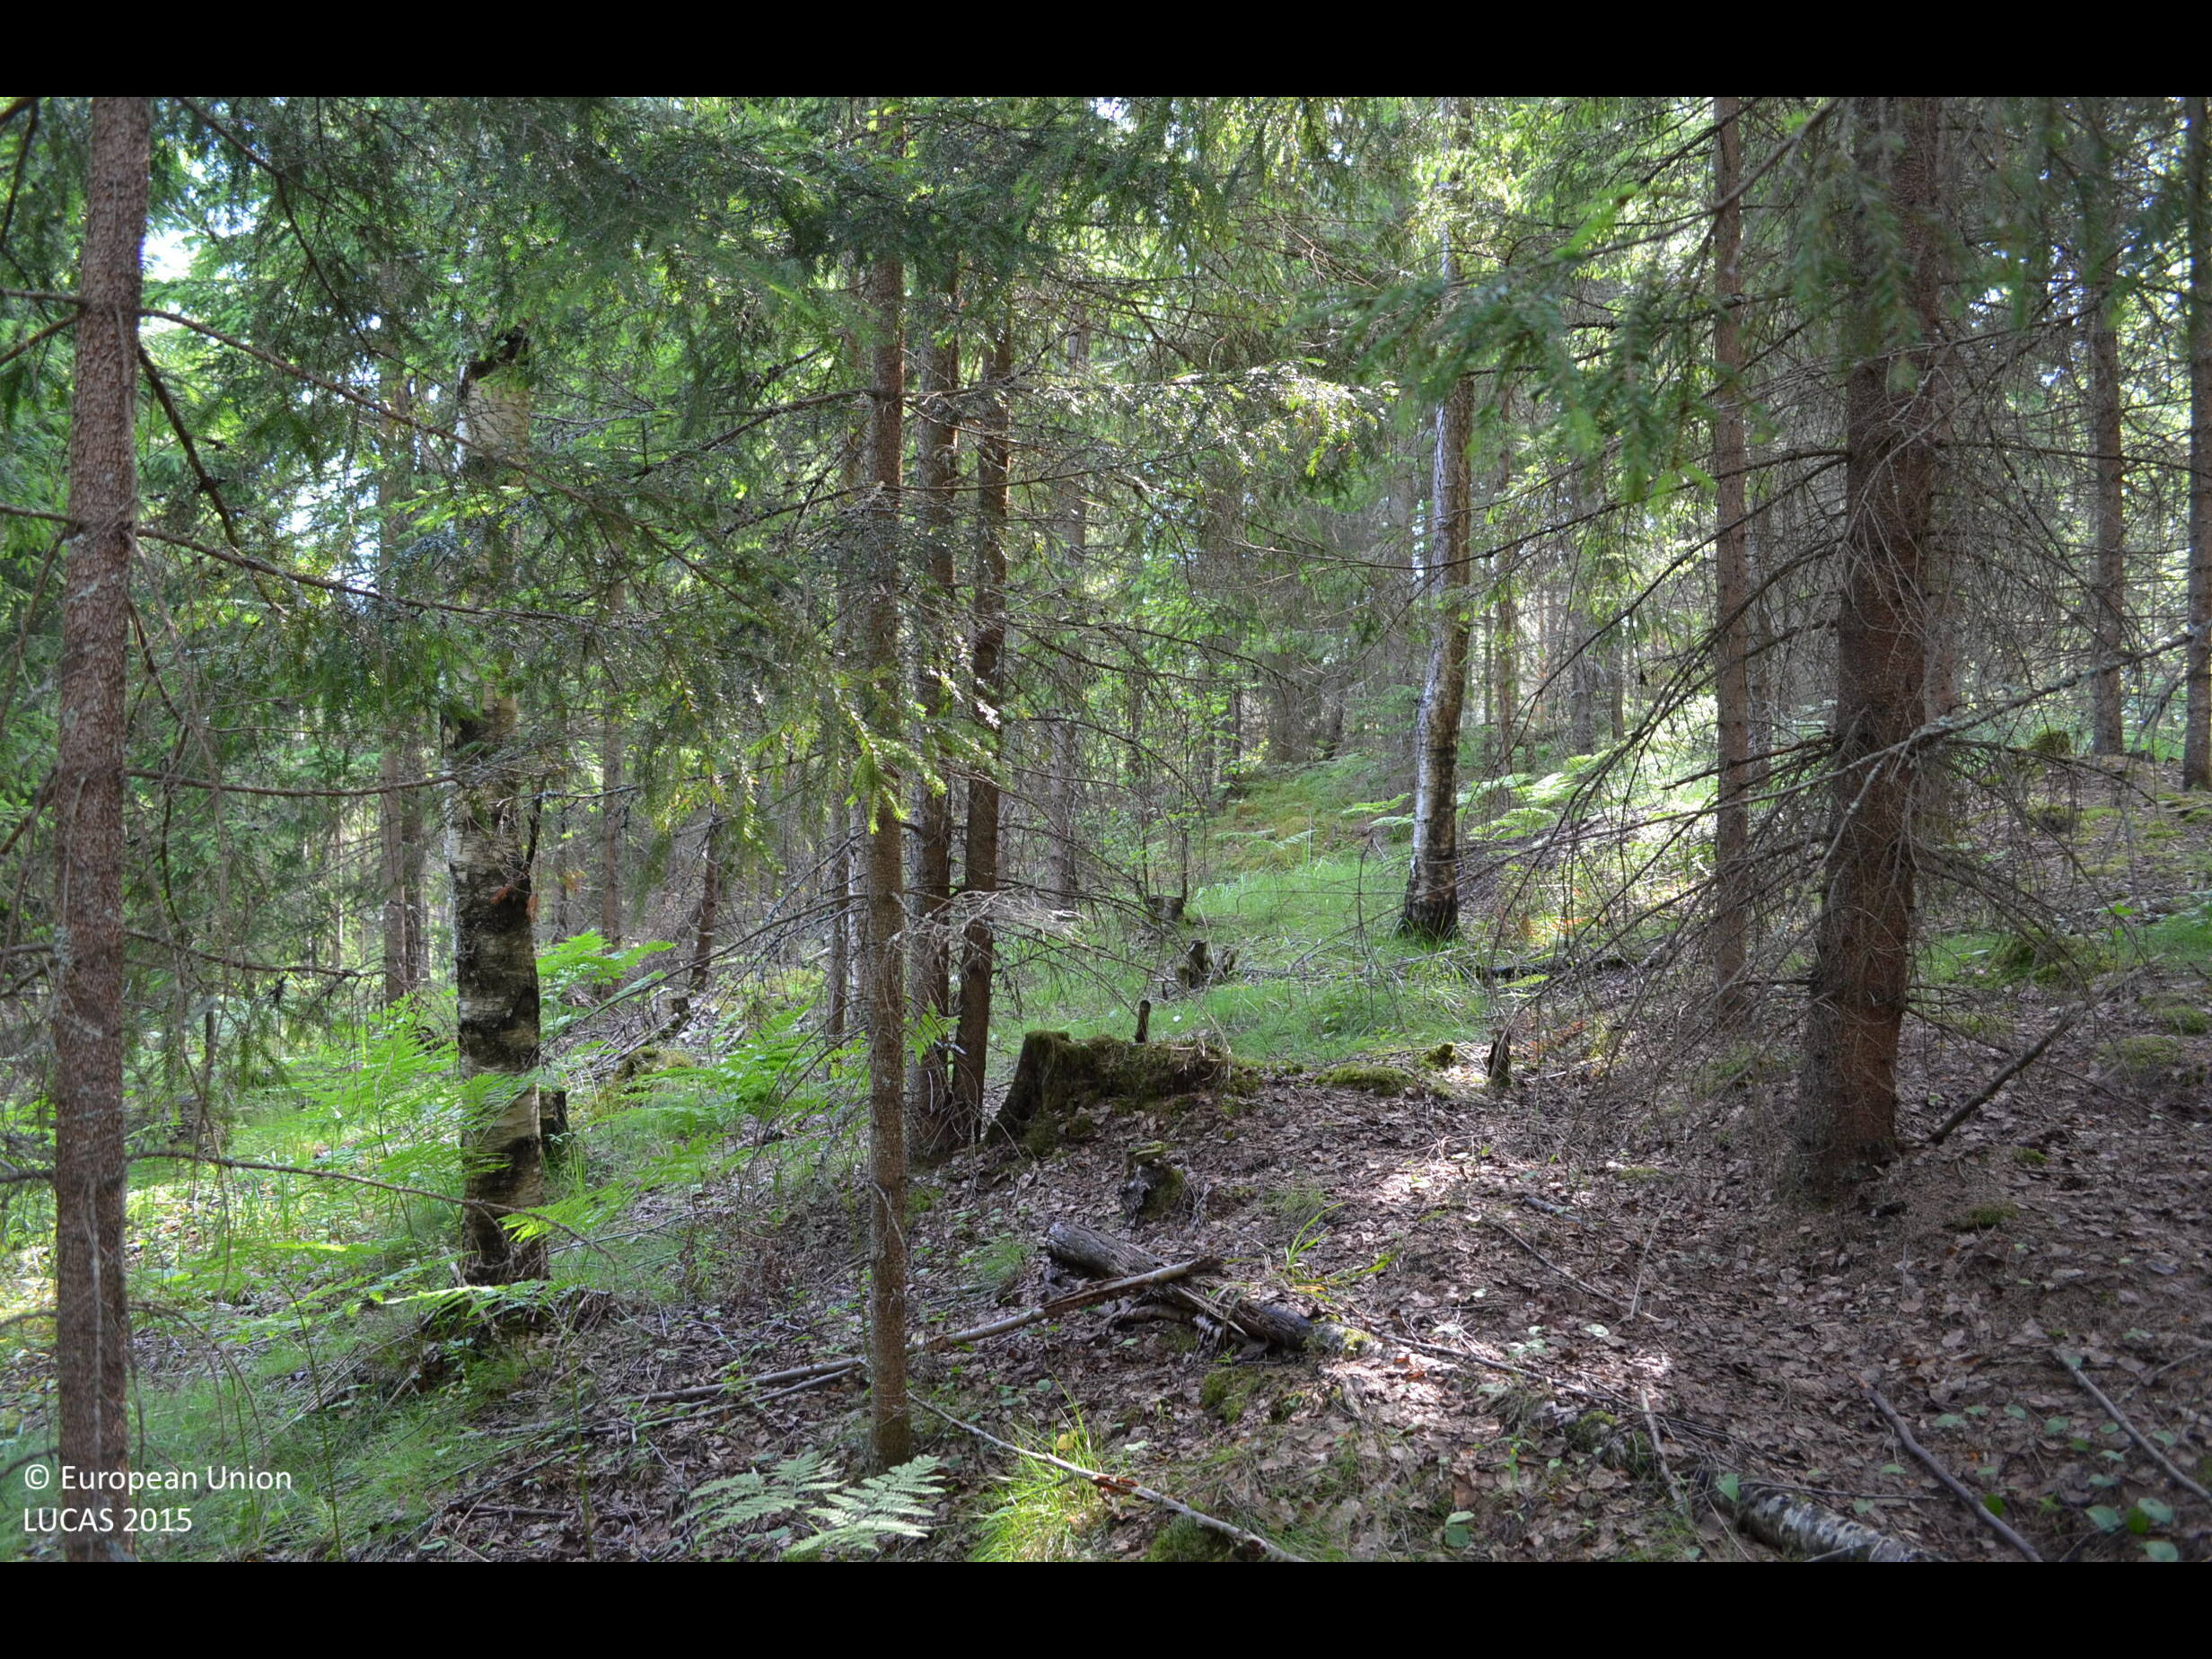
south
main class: Woodland
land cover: Spruce dominated mixed woodland
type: boreal forest
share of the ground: > 75 %
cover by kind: coniferous forest trees 55 %, broadleaved forest trees 20 %, shrubs 10 %, herbaceous plants 5 %, lichens and mosses 5 %
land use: Forestry
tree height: > 5 m
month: July
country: FI
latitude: 61.8388
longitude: 23.4665
